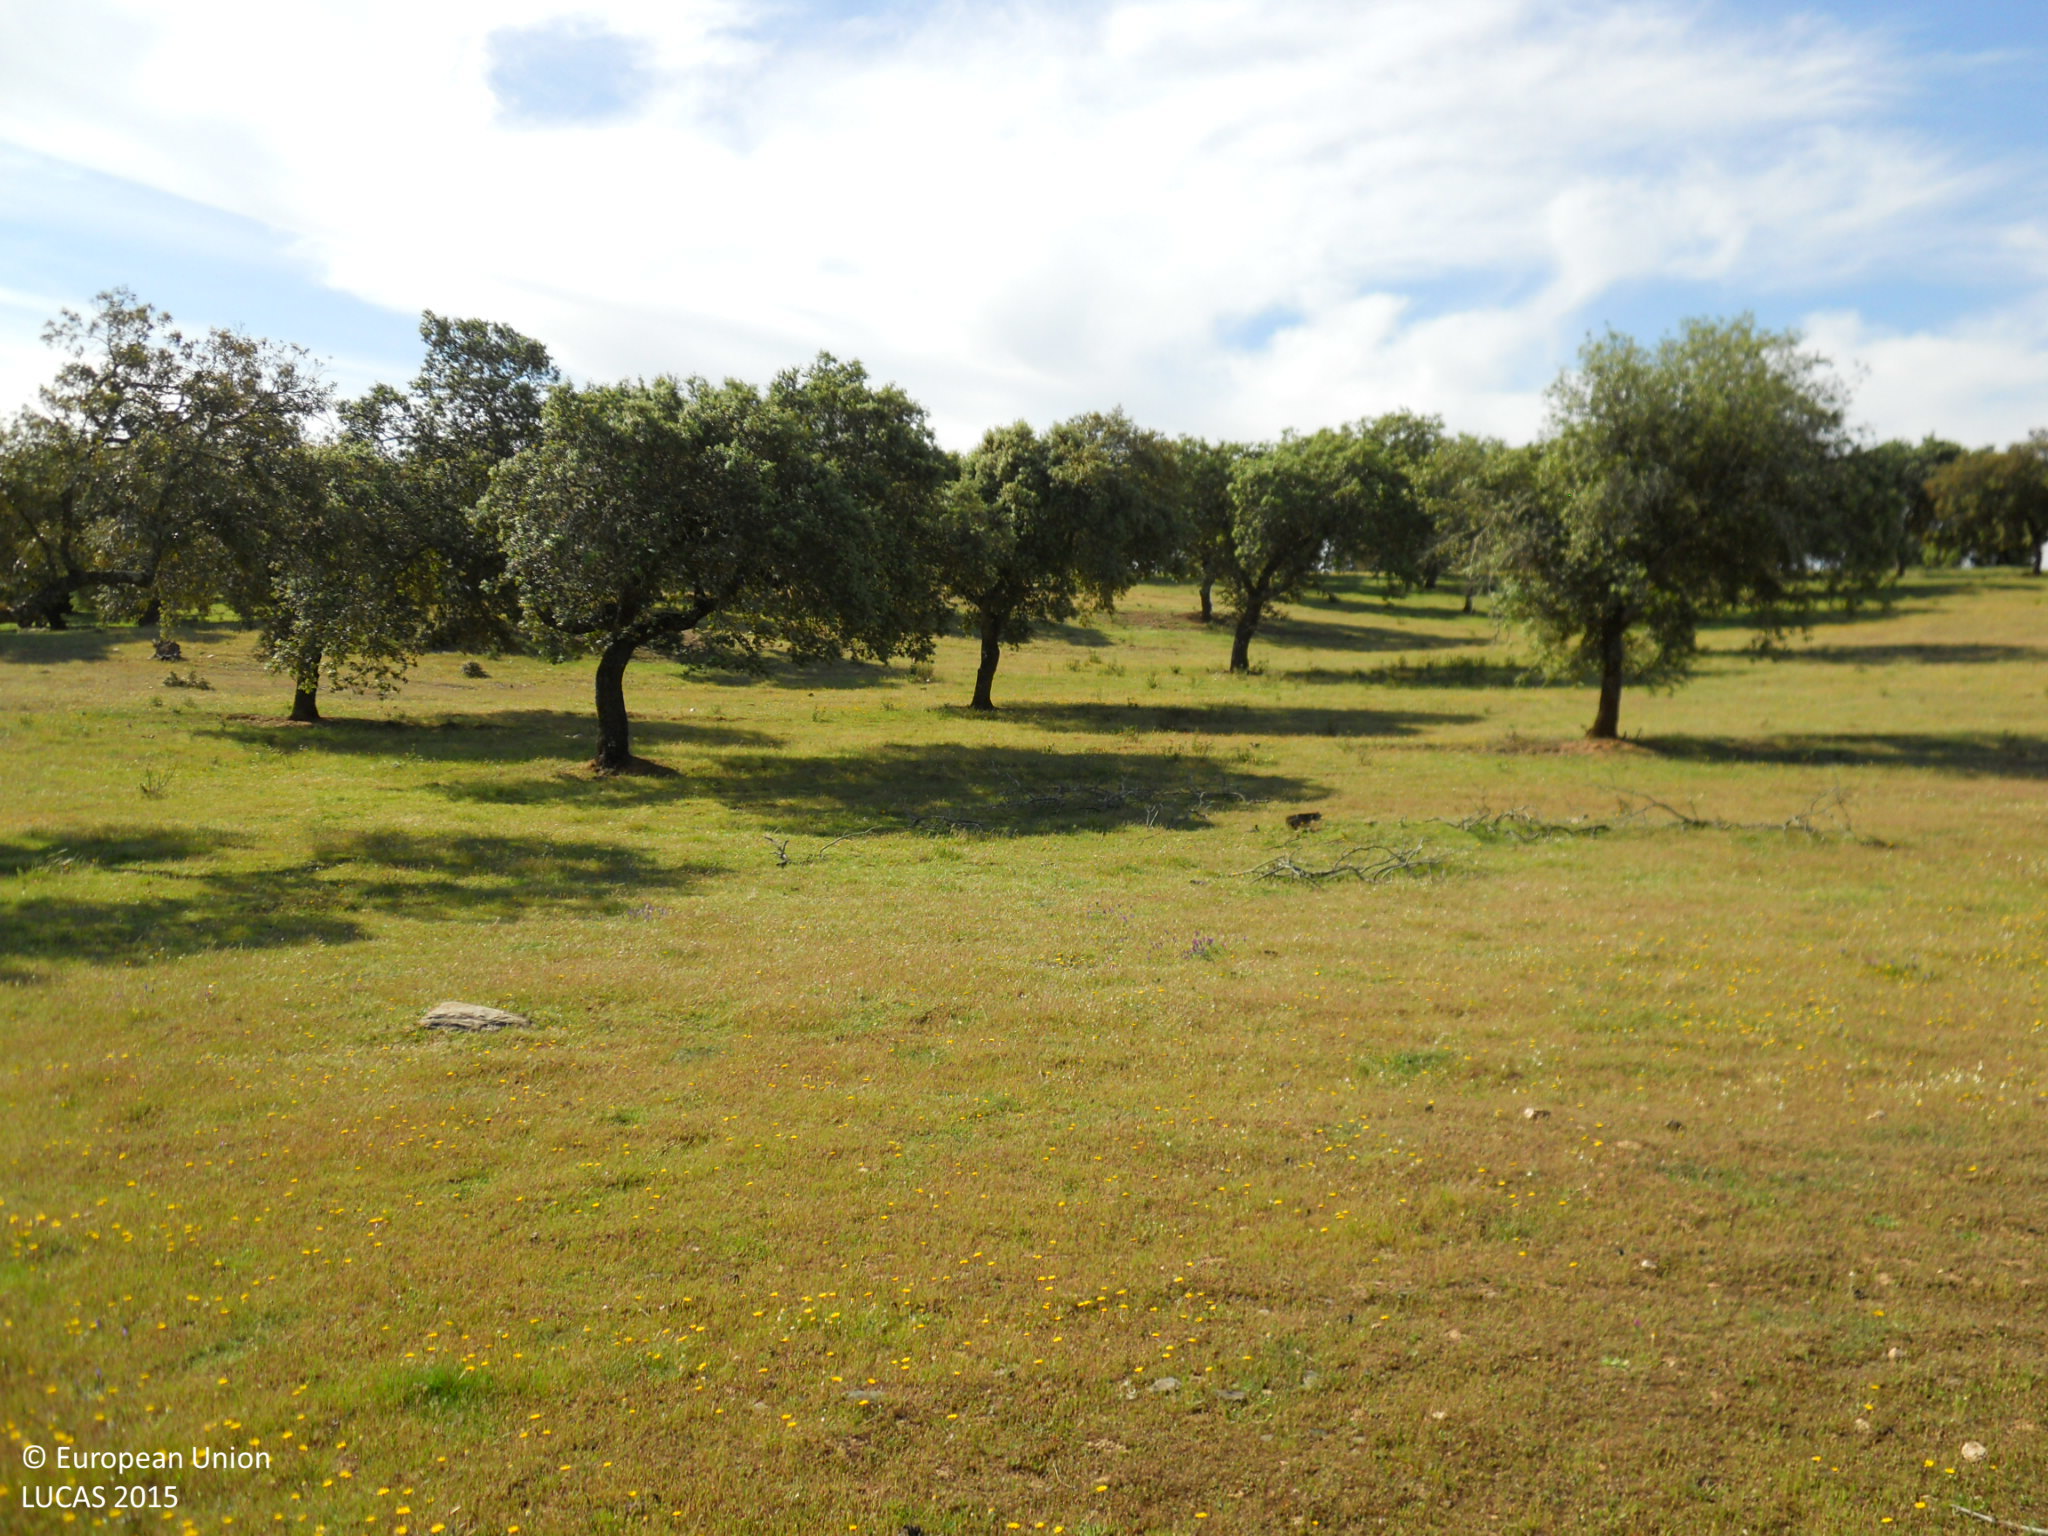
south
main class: Grassland
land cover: Grassland with sparse tree/shrub cover
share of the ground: > 75 %
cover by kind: herbaceous plants 95 %, broadleaved forest trees 5 %
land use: Agriculture (excluding fallow land and kitchen gardens)
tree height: > 5 m
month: April
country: ES
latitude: 39.1913
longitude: -6.9203
